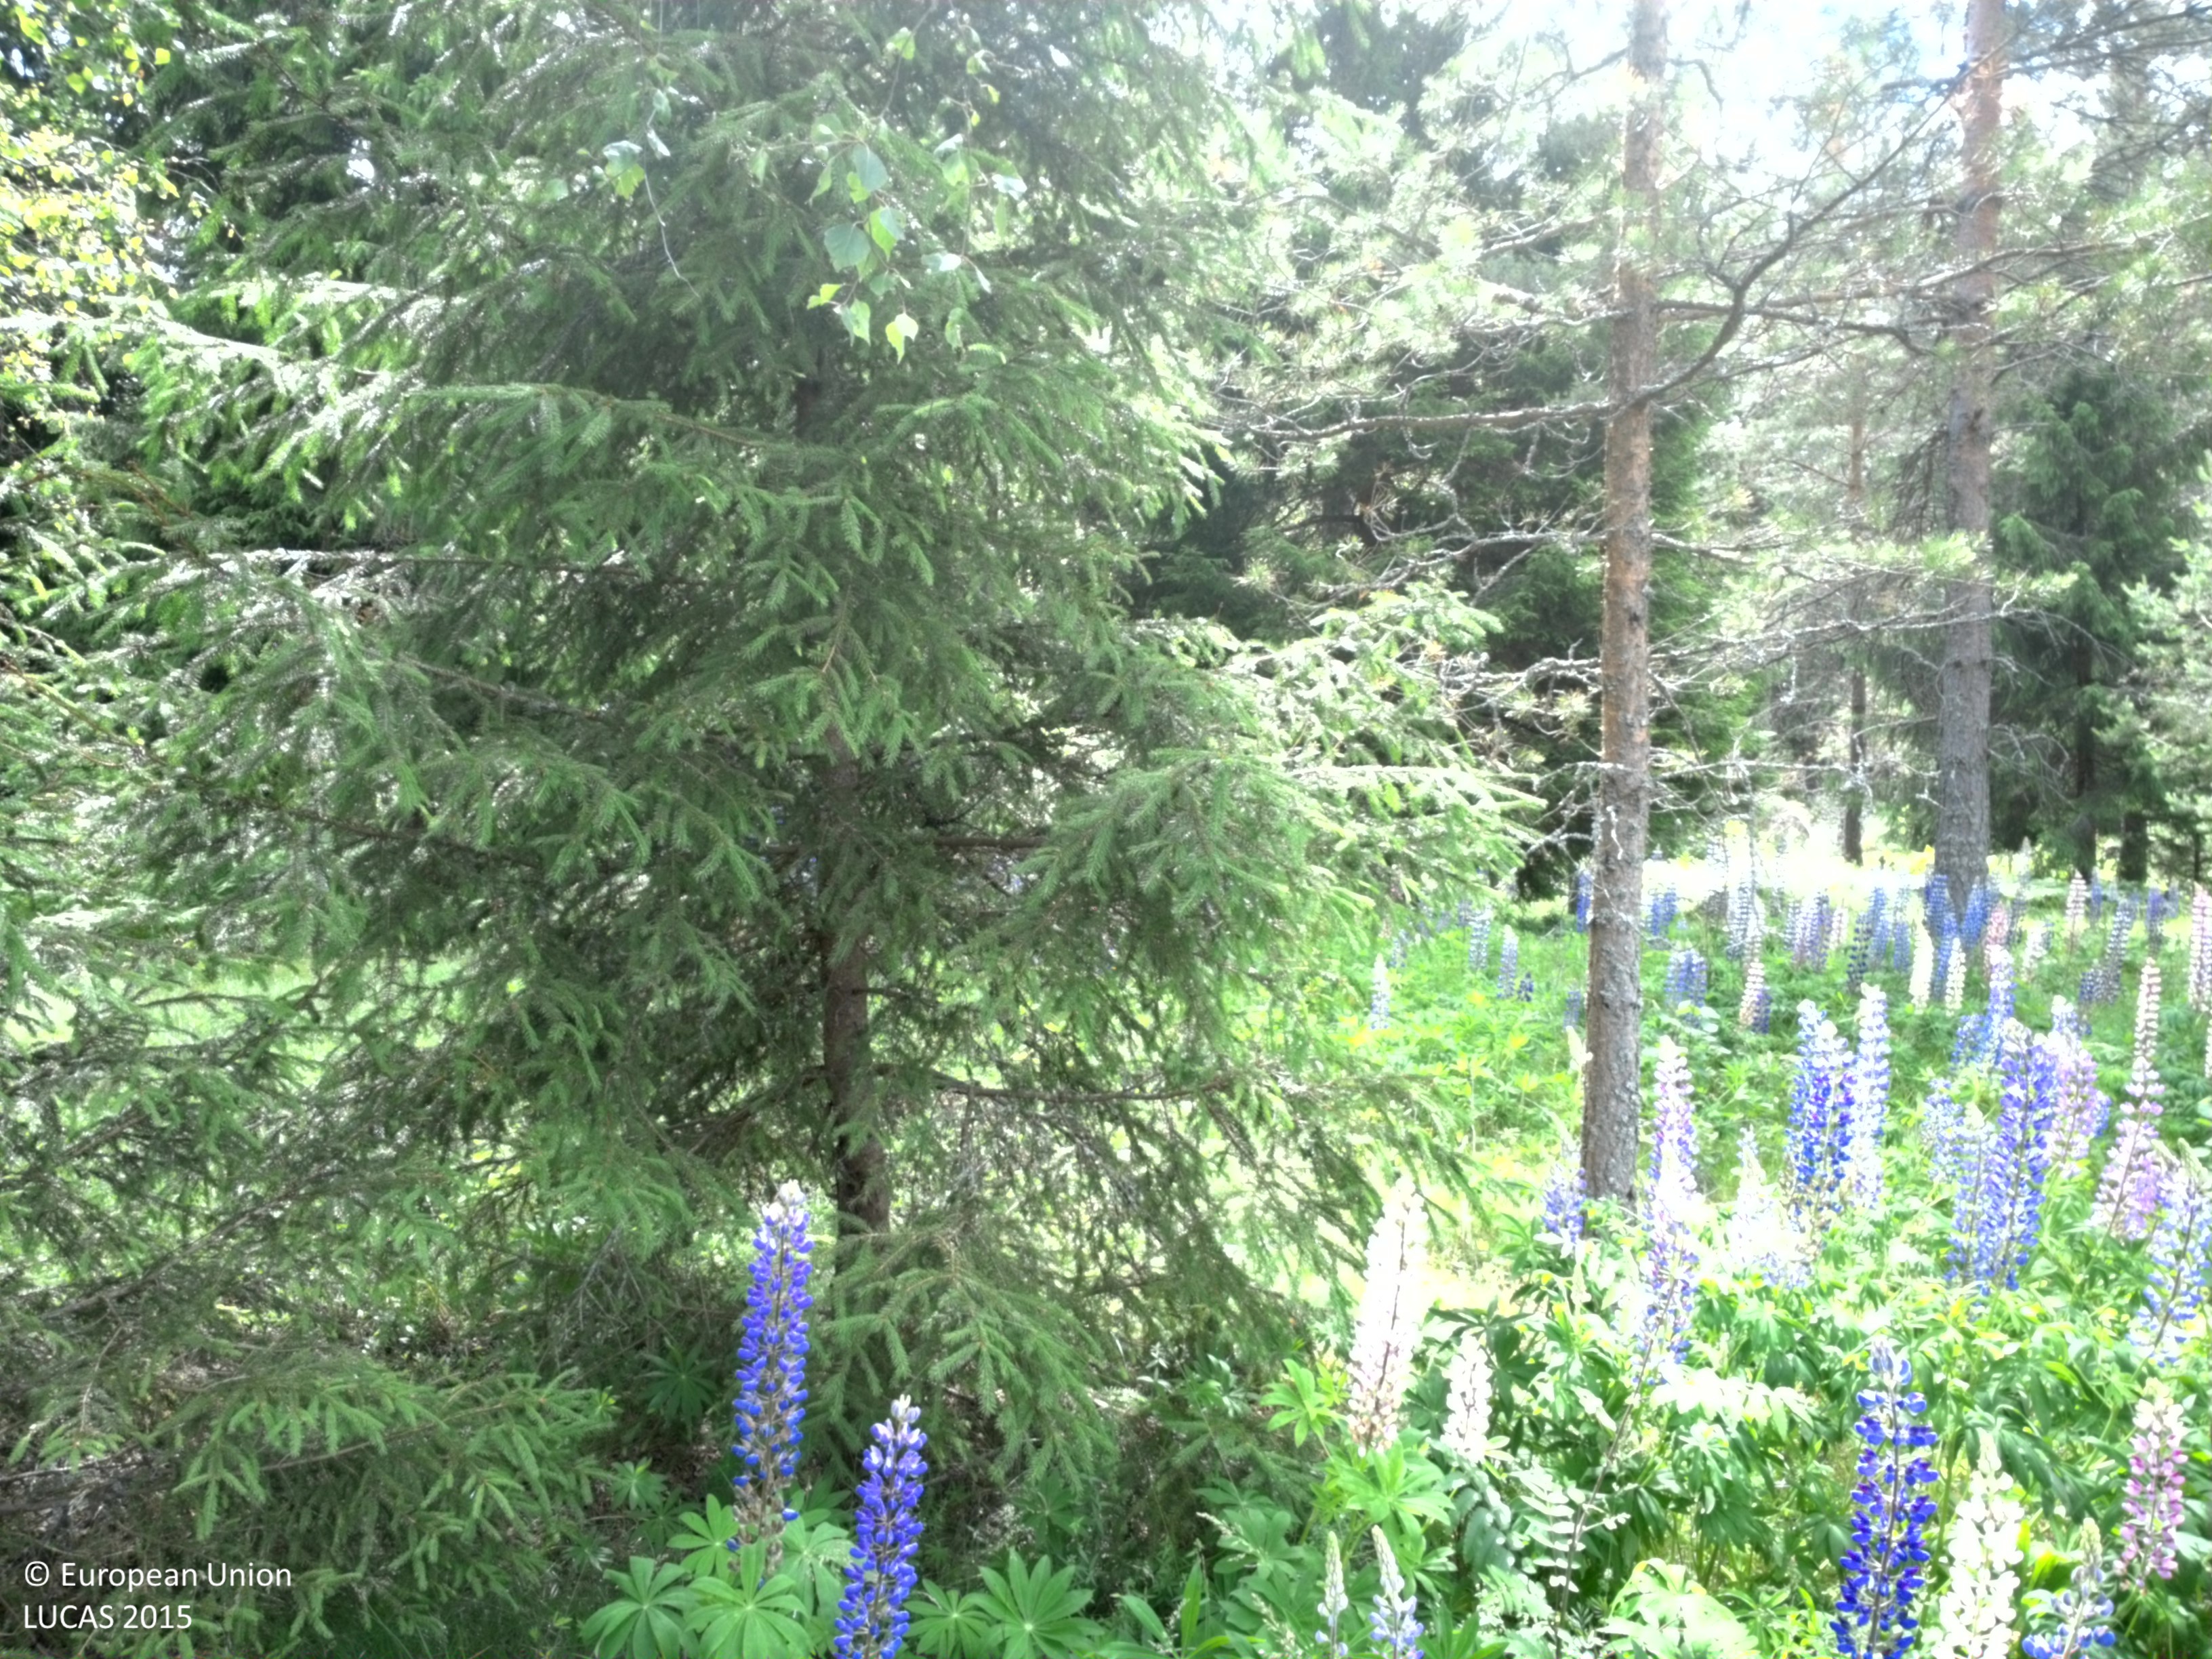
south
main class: Woodland
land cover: Pine dominated mixed woodland
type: boreal forest
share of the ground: 25 - 50 %
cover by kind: herbaceous plants 60 %, coniferous forest trees 25 %, broadleaved forest trees 15 %
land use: Forestry
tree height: > 5 m
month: July
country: SE
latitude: 60.0424
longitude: 17.0112
